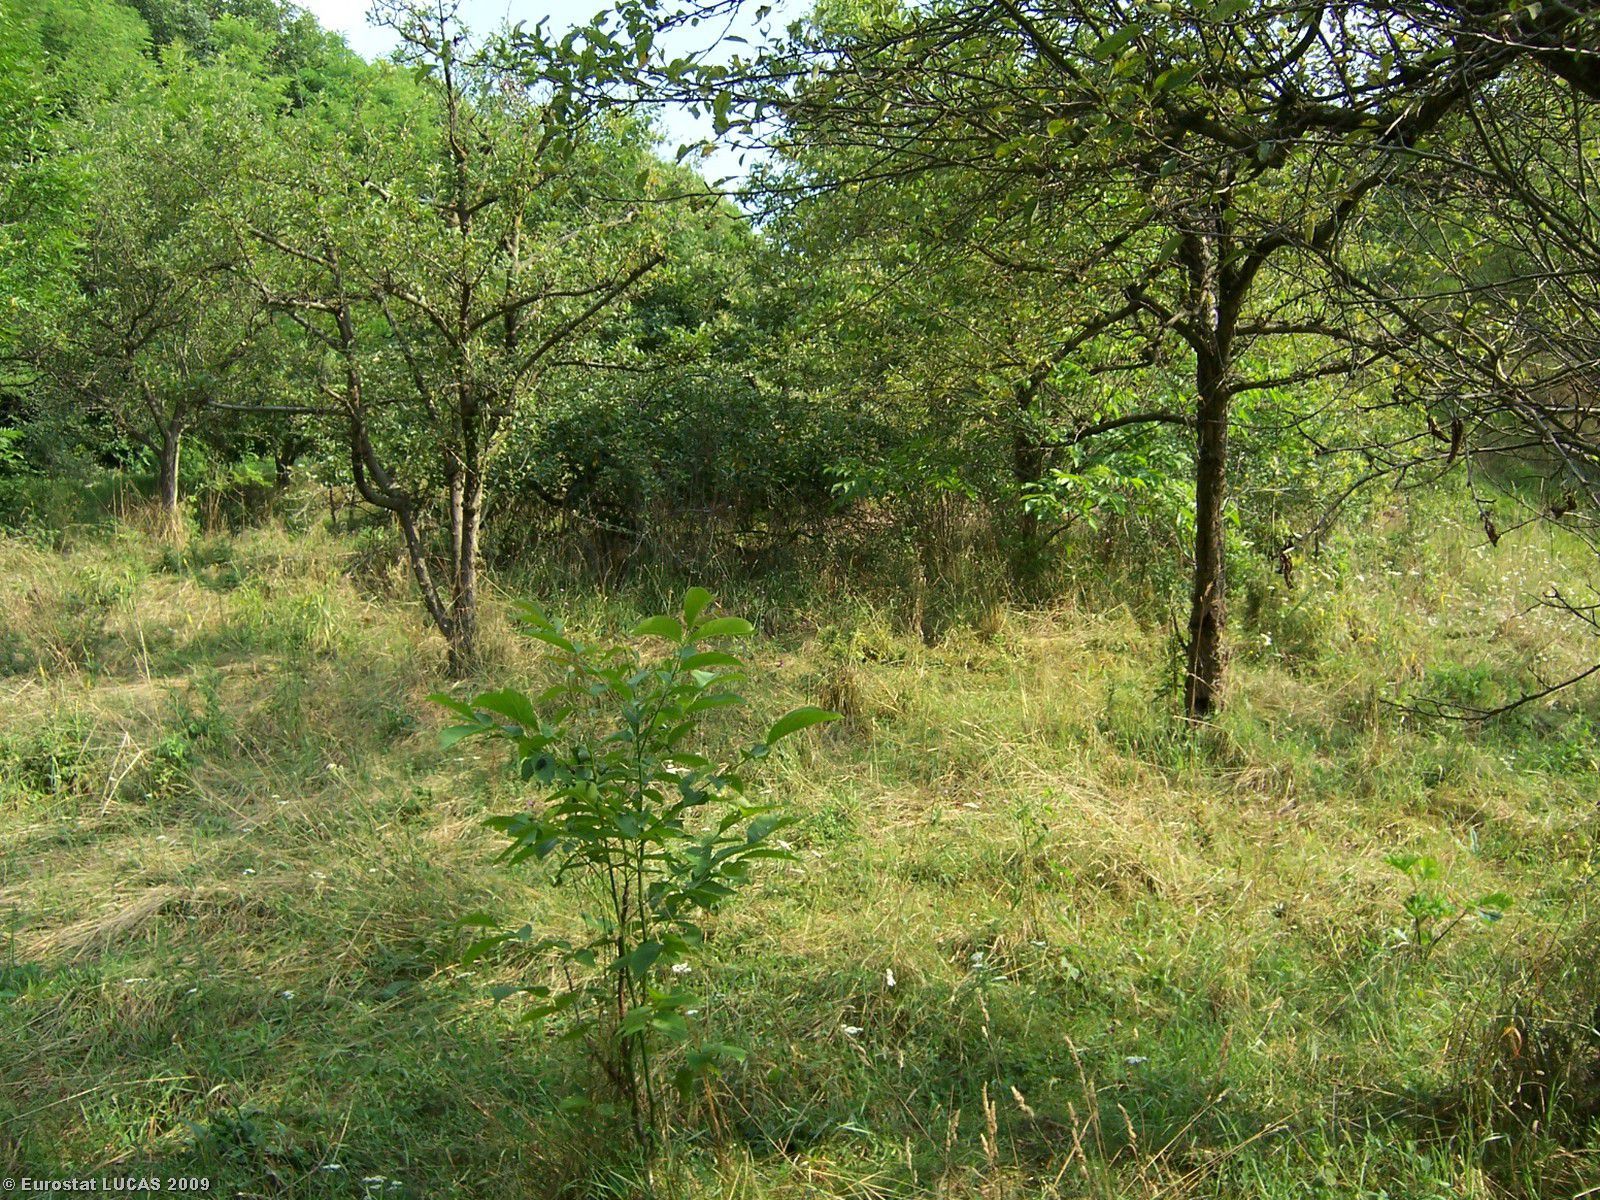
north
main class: Cropland
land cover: Apple fruit
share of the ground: > 75 %
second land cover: Grassland with sparse tree/shrub cover
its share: > 75 %
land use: Agriculture (excluding fallow land and kitchen gardens)
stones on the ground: < 10 %
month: July
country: IT
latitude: 44.9670
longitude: 7.3801
